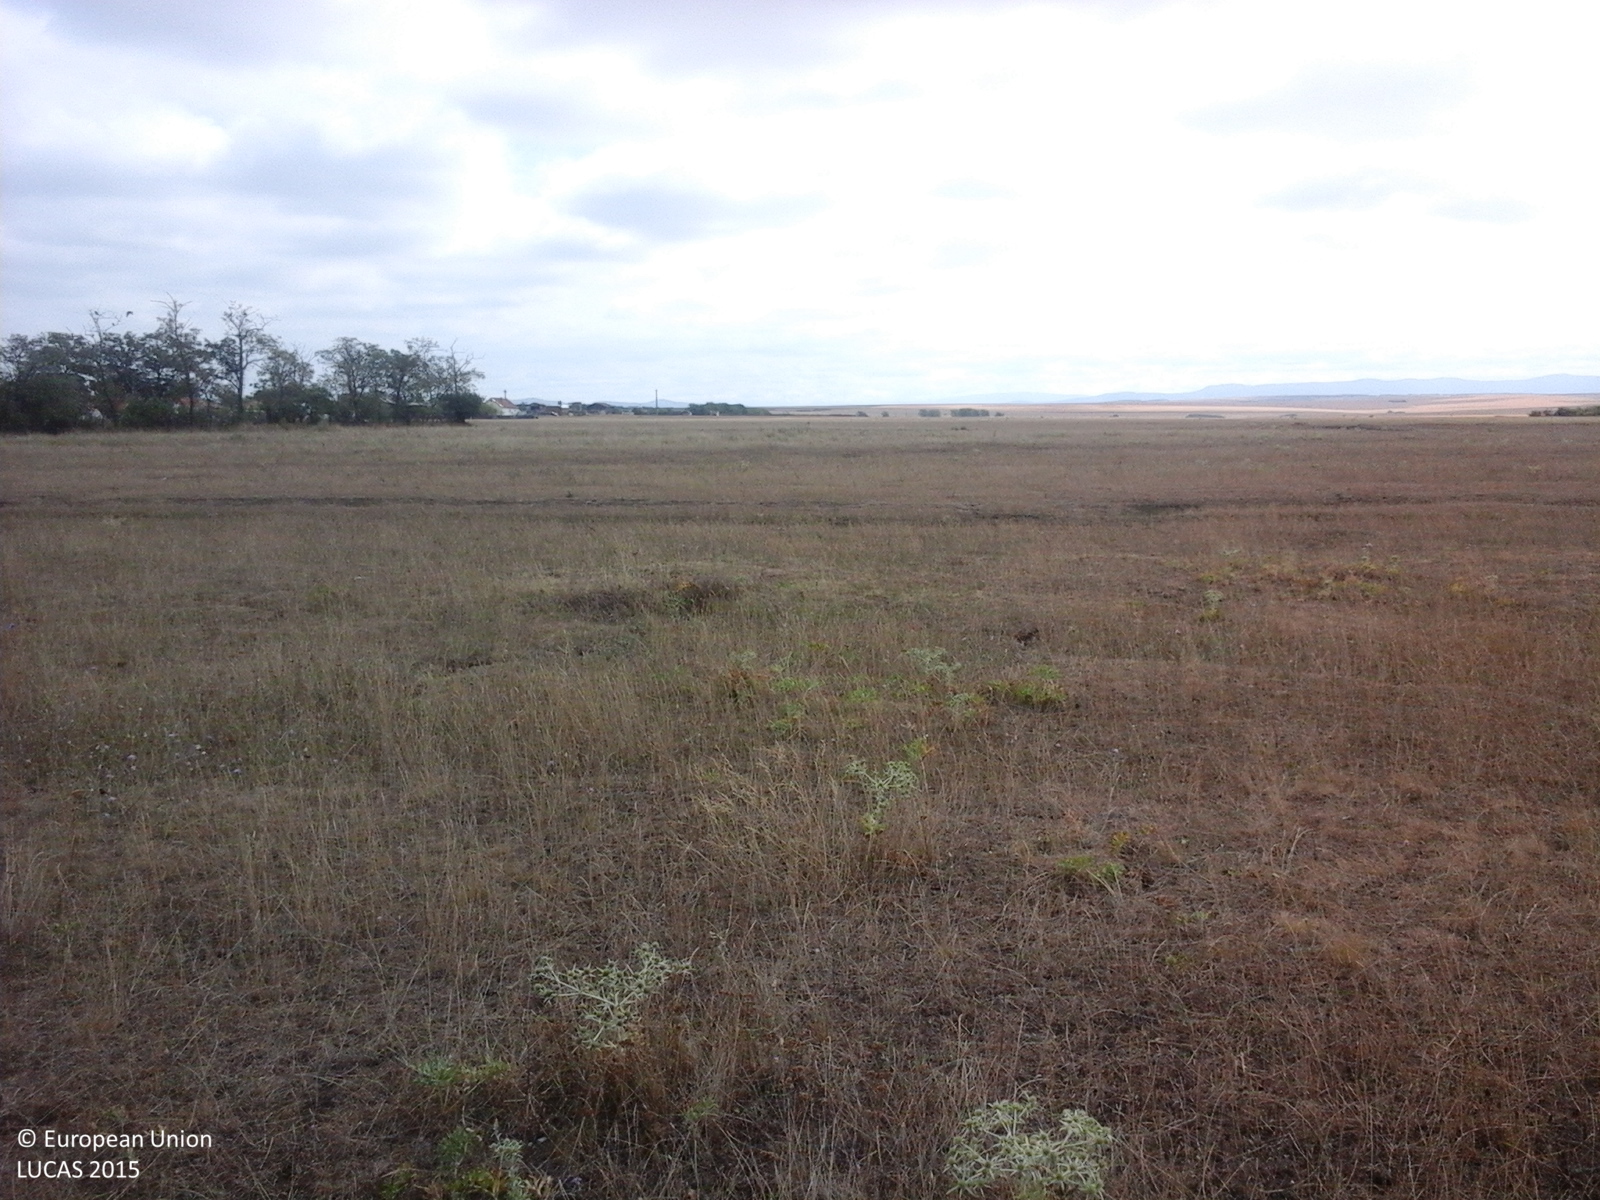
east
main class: Grassland
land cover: Grassland without tree/shrub cover
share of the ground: > 75 %
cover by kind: herbaceous plants 100 %
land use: Agriculture (excluding fallow land and kitchen gardens)
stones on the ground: < 10 %
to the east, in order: Grassland without tree/shrub cover; Tracks; Grassland without tree/shrub cover; Tracks; Grassland without tree/shrub cover
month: August
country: RO
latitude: 45.4023
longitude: 21.4913
